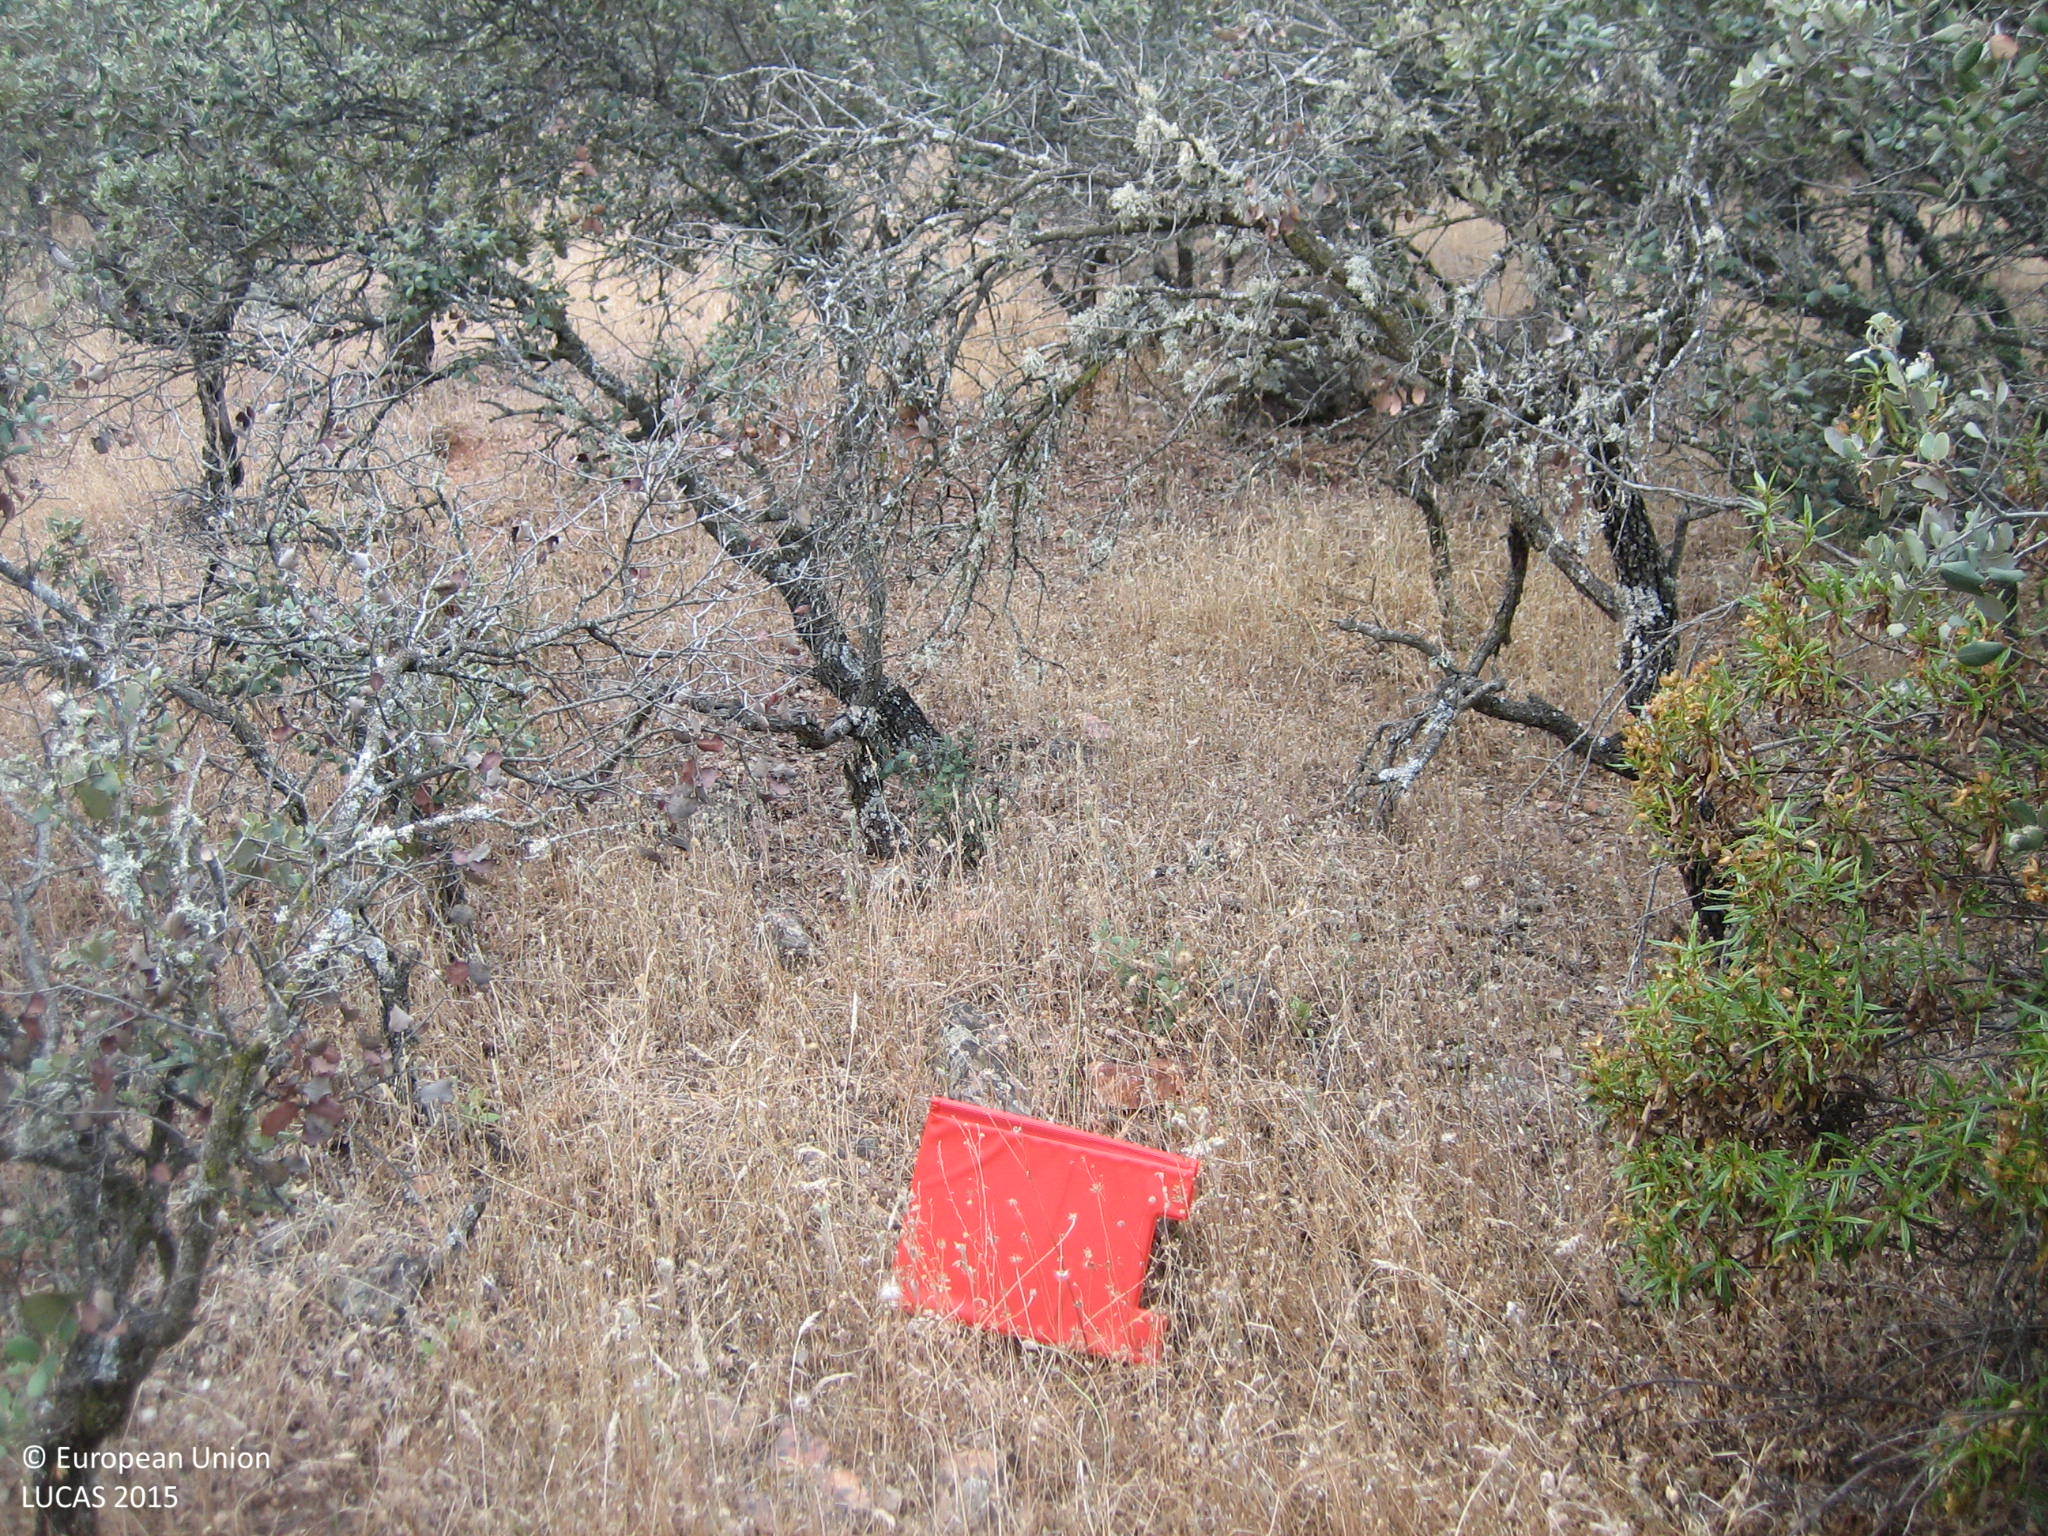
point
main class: Woodland
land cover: Broadleaved woodland
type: broadleaved evergreen forest
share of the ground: 50 - 75 %
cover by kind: broadleaved forest trees 70 %, herbaceous plants 30 %
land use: Semi-natural and natural areas not in use
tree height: < 5 m
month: May
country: ES
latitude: 38.8305
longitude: -4.0385
